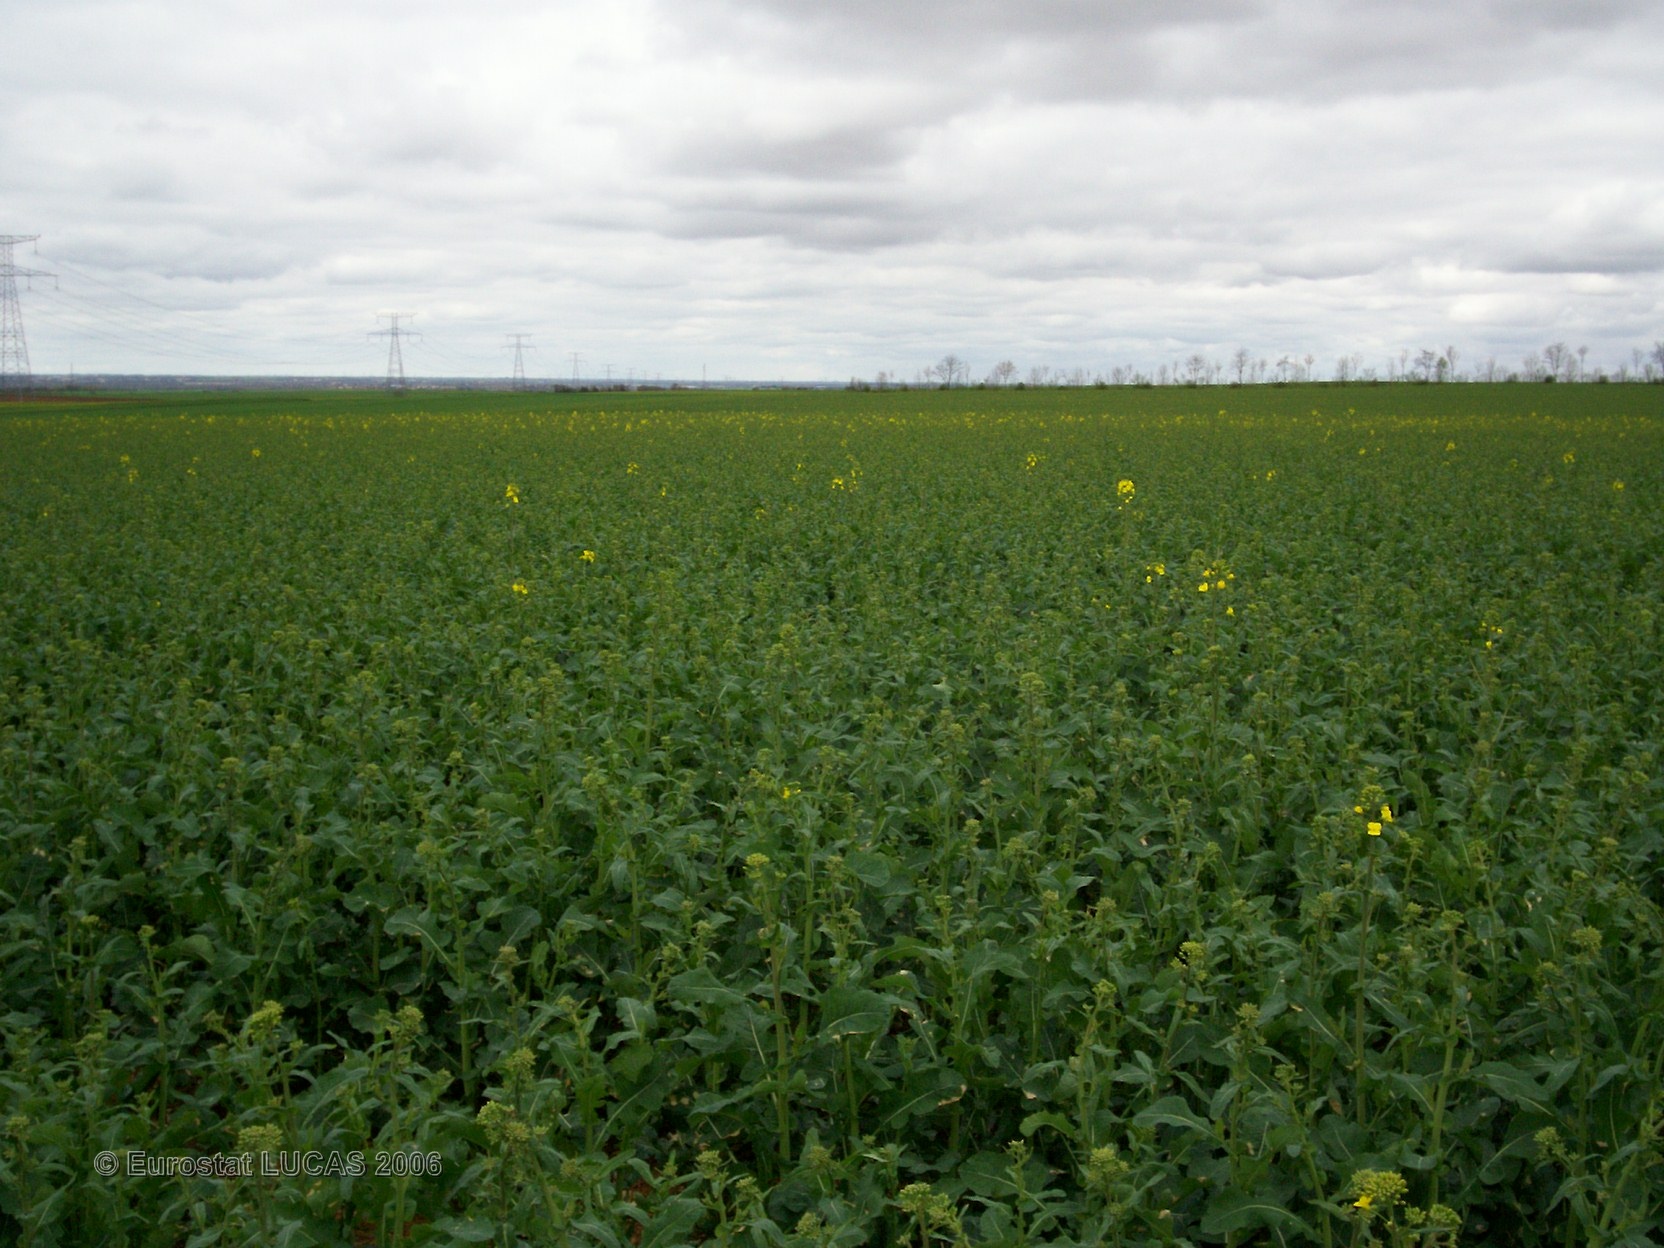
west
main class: Cropland
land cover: Rape and turnip rape
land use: Agriculture (excluding fallow land and kitchen gardens)
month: April
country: FR
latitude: 46.2738
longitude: -0.2616
